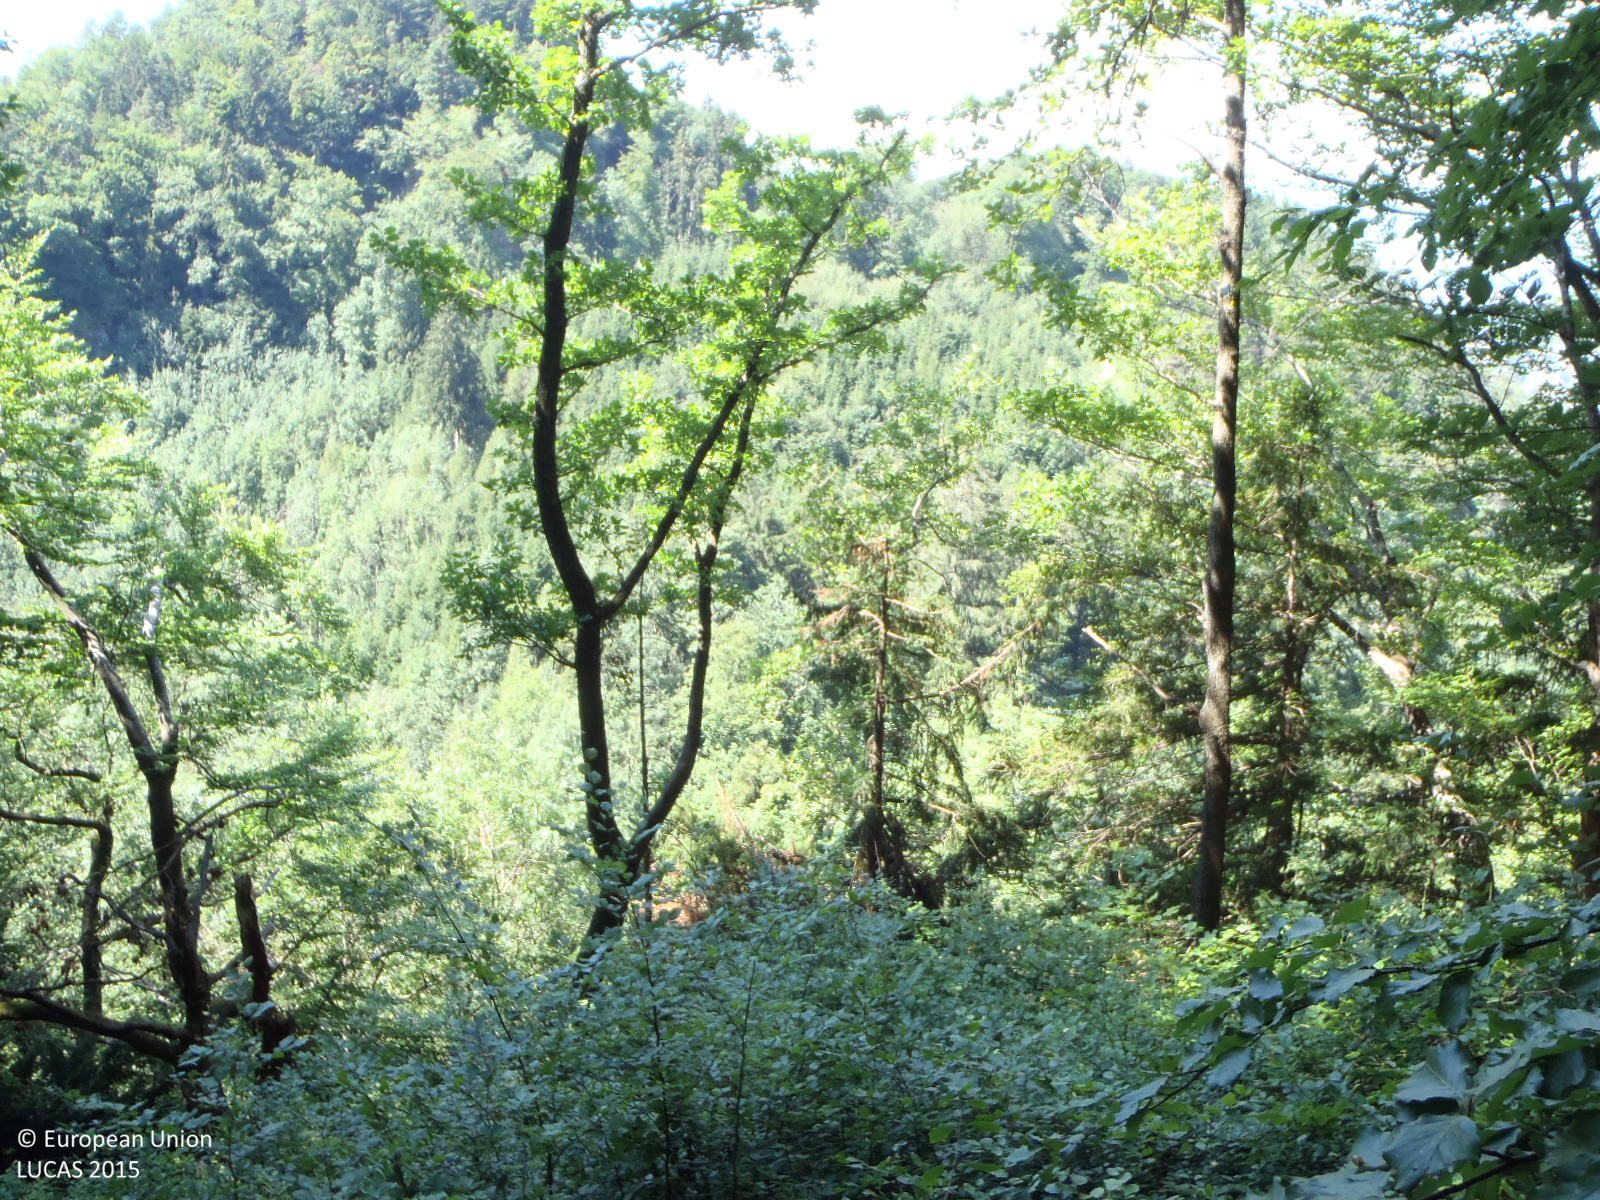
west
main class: Woodland
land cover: Broadleaved woodland
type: mountainous beech forest
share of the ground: > 75 %
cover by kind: broadleaved forest trees 80 %, coniferous forest trees 10 %, herbaceous plants 10 %
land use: Forestry
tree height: > 5 m
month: July
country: AT
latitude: 47.3411
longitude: 9.6694
